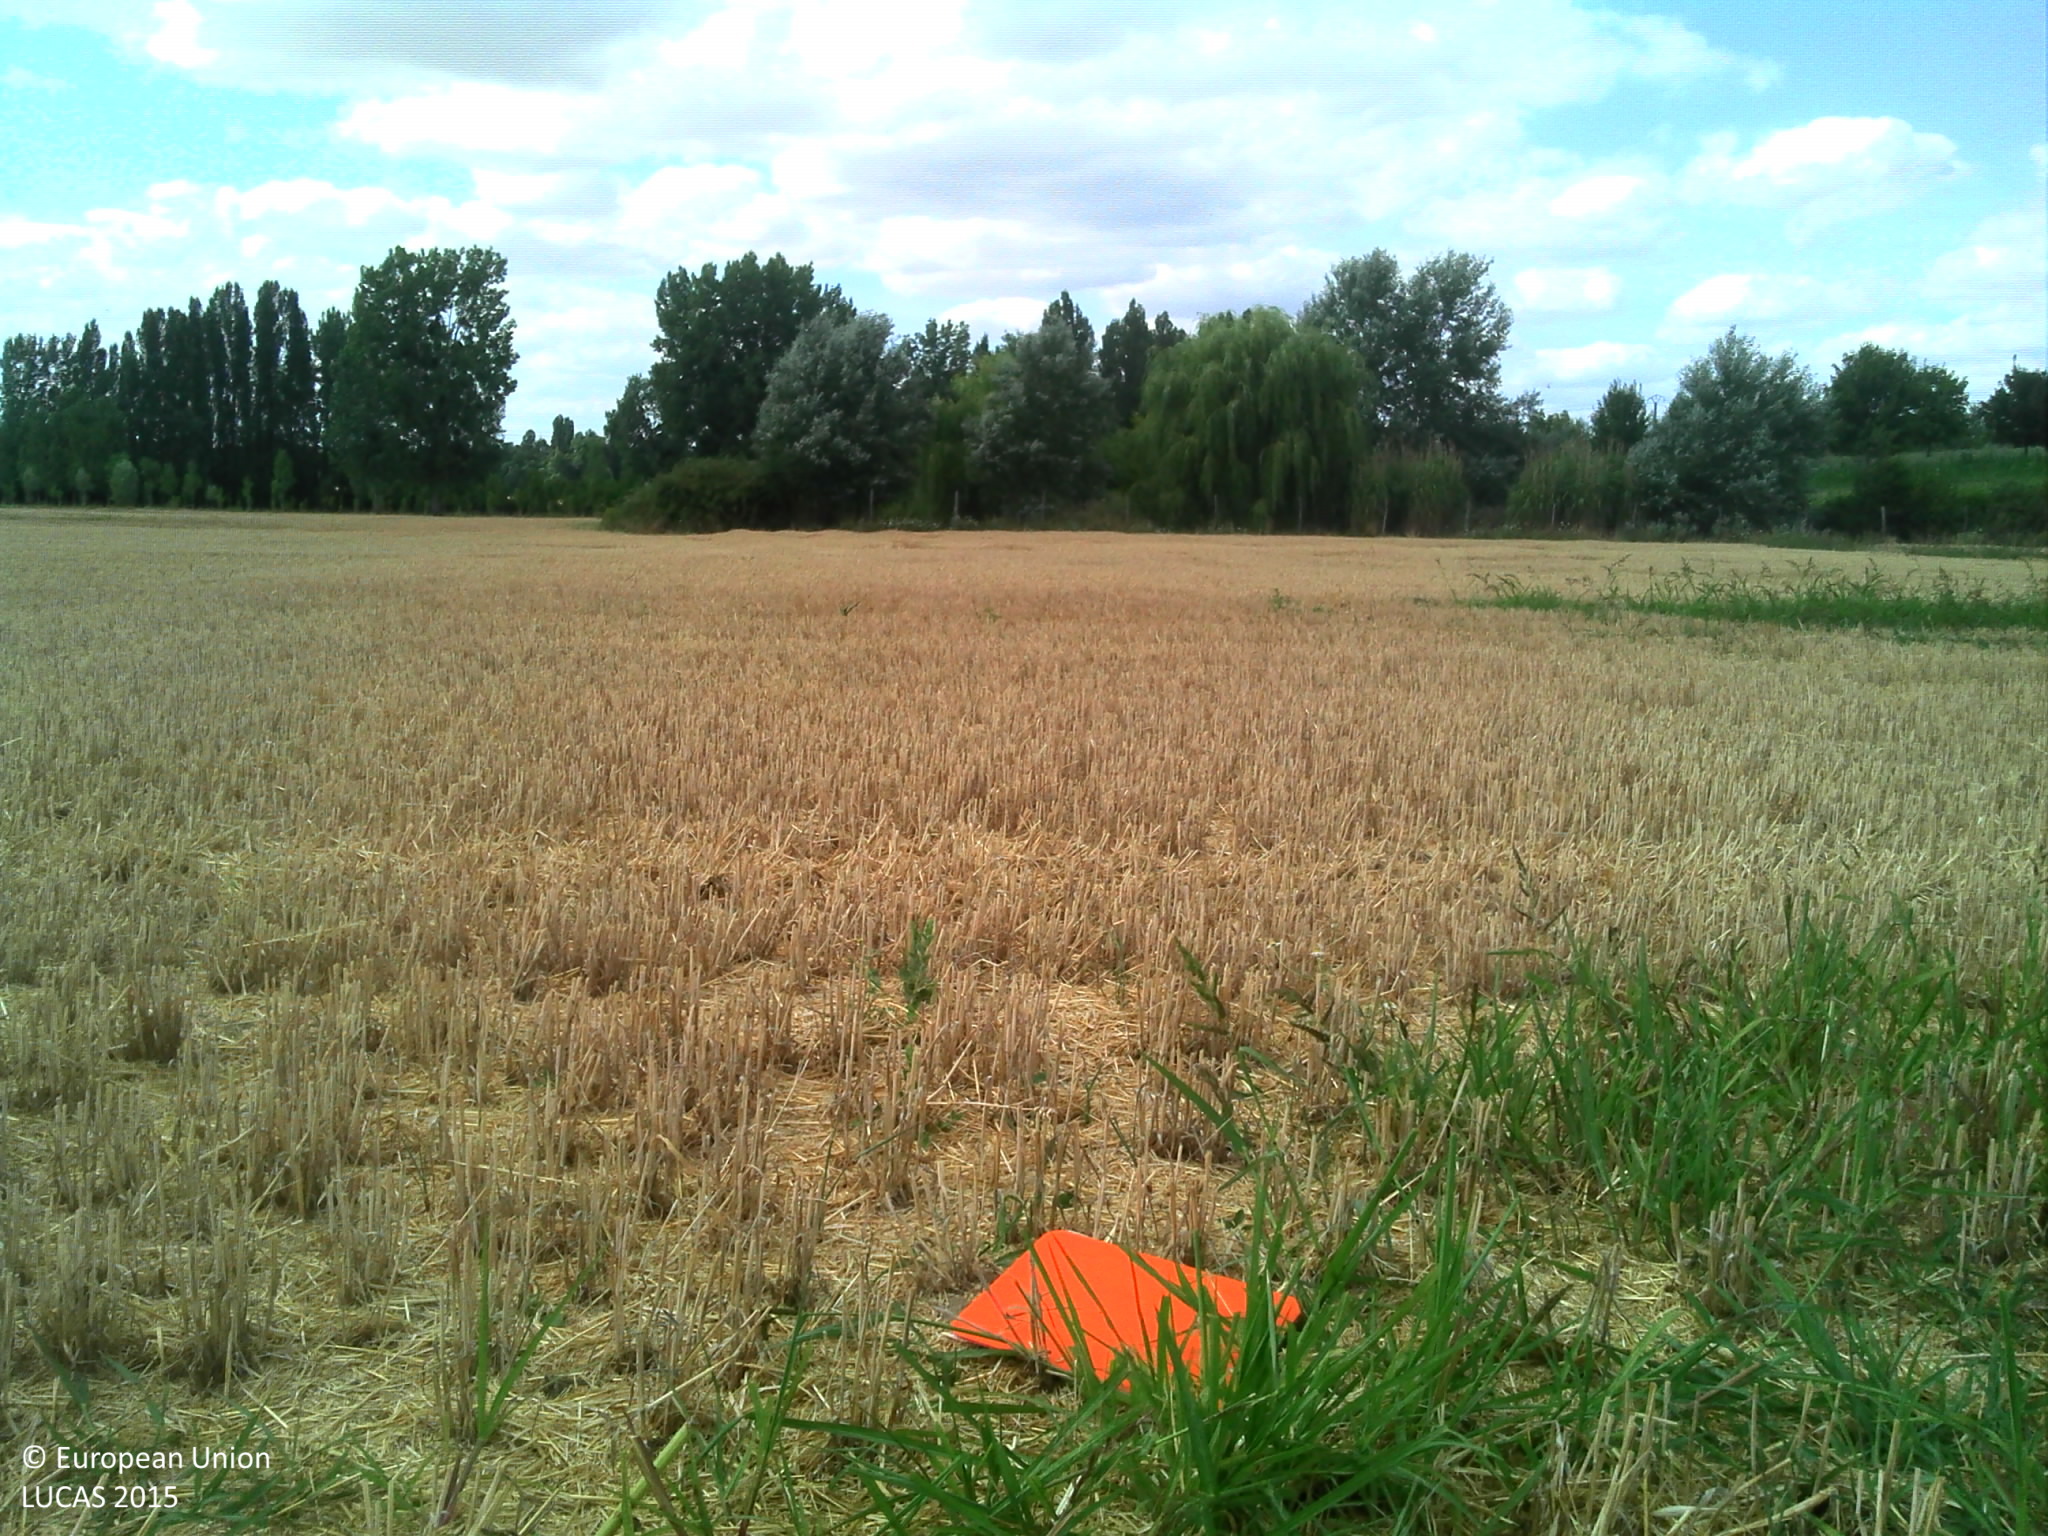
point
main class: Cropland
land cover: Common wheat
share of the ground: > 75 %
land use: Agriculture (excluding fallow land and kitchen gardens)
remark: Harvested field
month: July
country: FR
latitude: 47.0620
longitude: 0.8323
